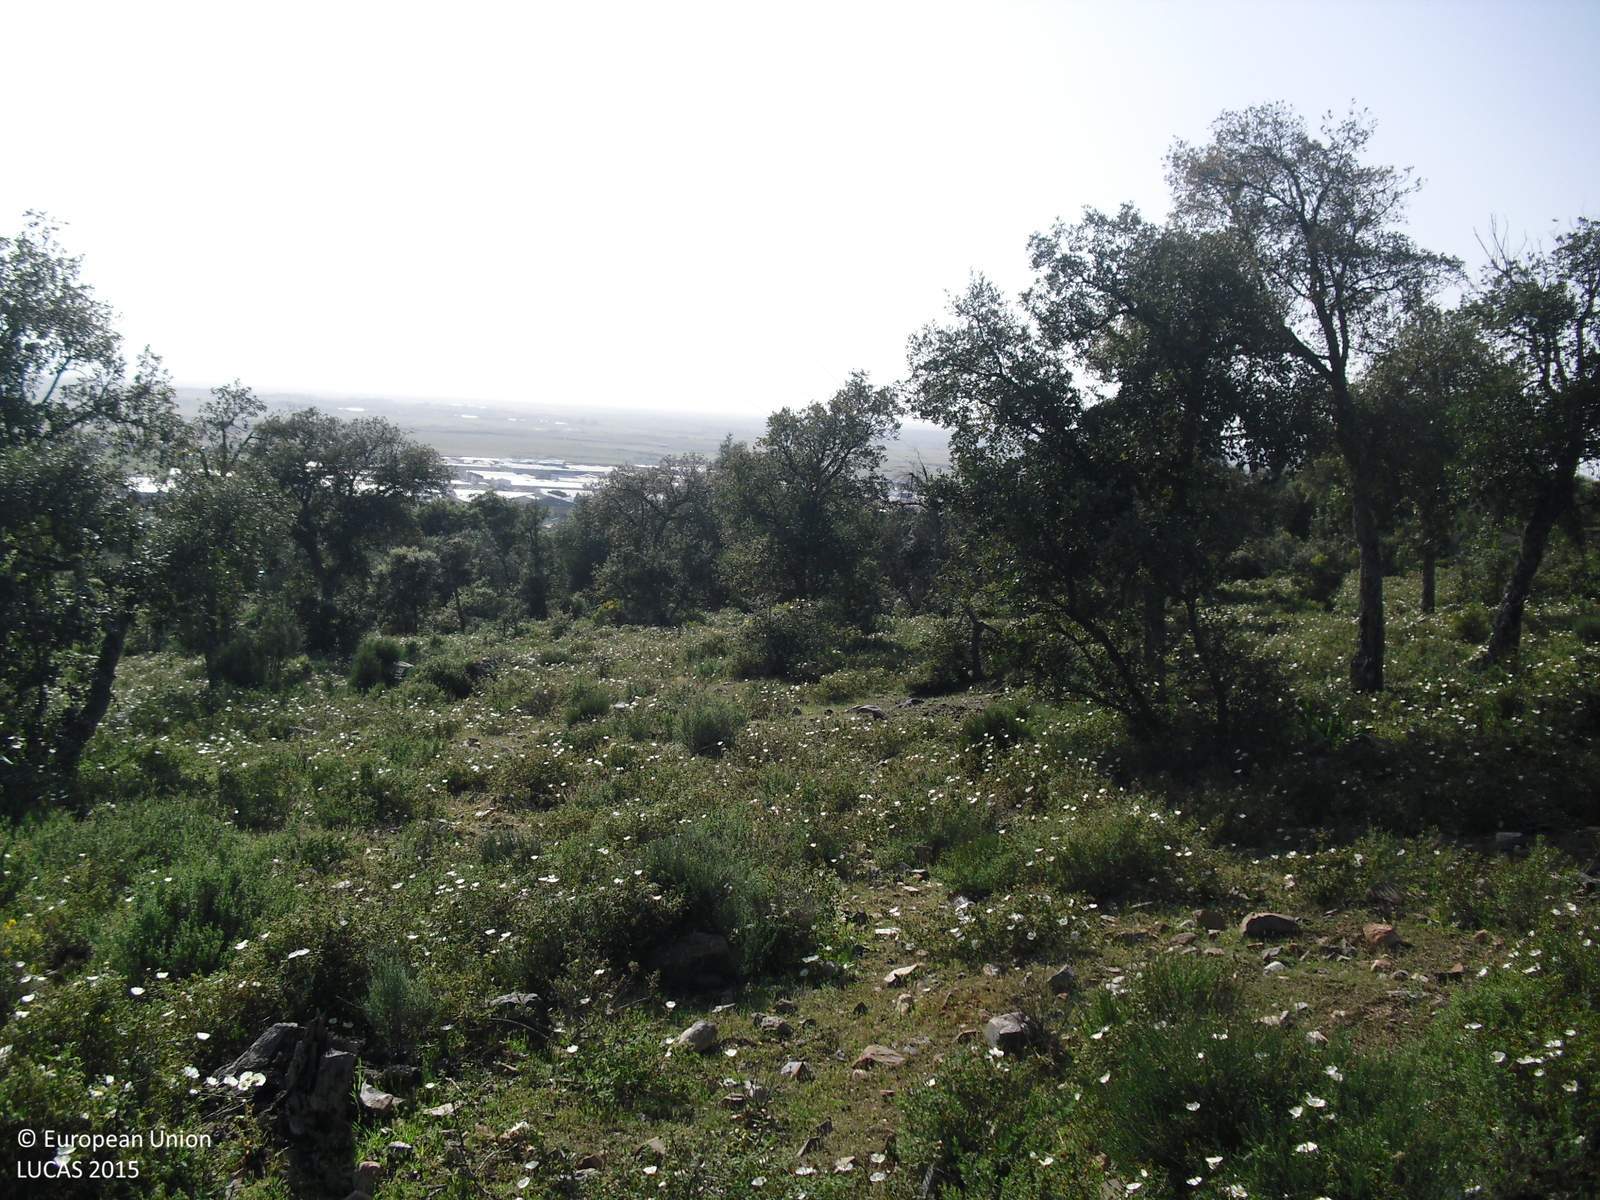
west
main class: Woodland
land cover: Broadleaved woodland
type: broadleaved evergreen forest
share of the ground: 25 - 50 %
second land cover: Grassland without tree/shrub cover
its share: > 75 %
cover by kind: herbaceous plants 60 %, broadleaved forest trees 30 %, shrubs 10 %
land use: Forestry
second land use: Agriculture (excluding fallow land and kitchen gardens)
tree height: > 5 m
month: April
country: ES
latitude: 39.4839
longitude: -6.4036
